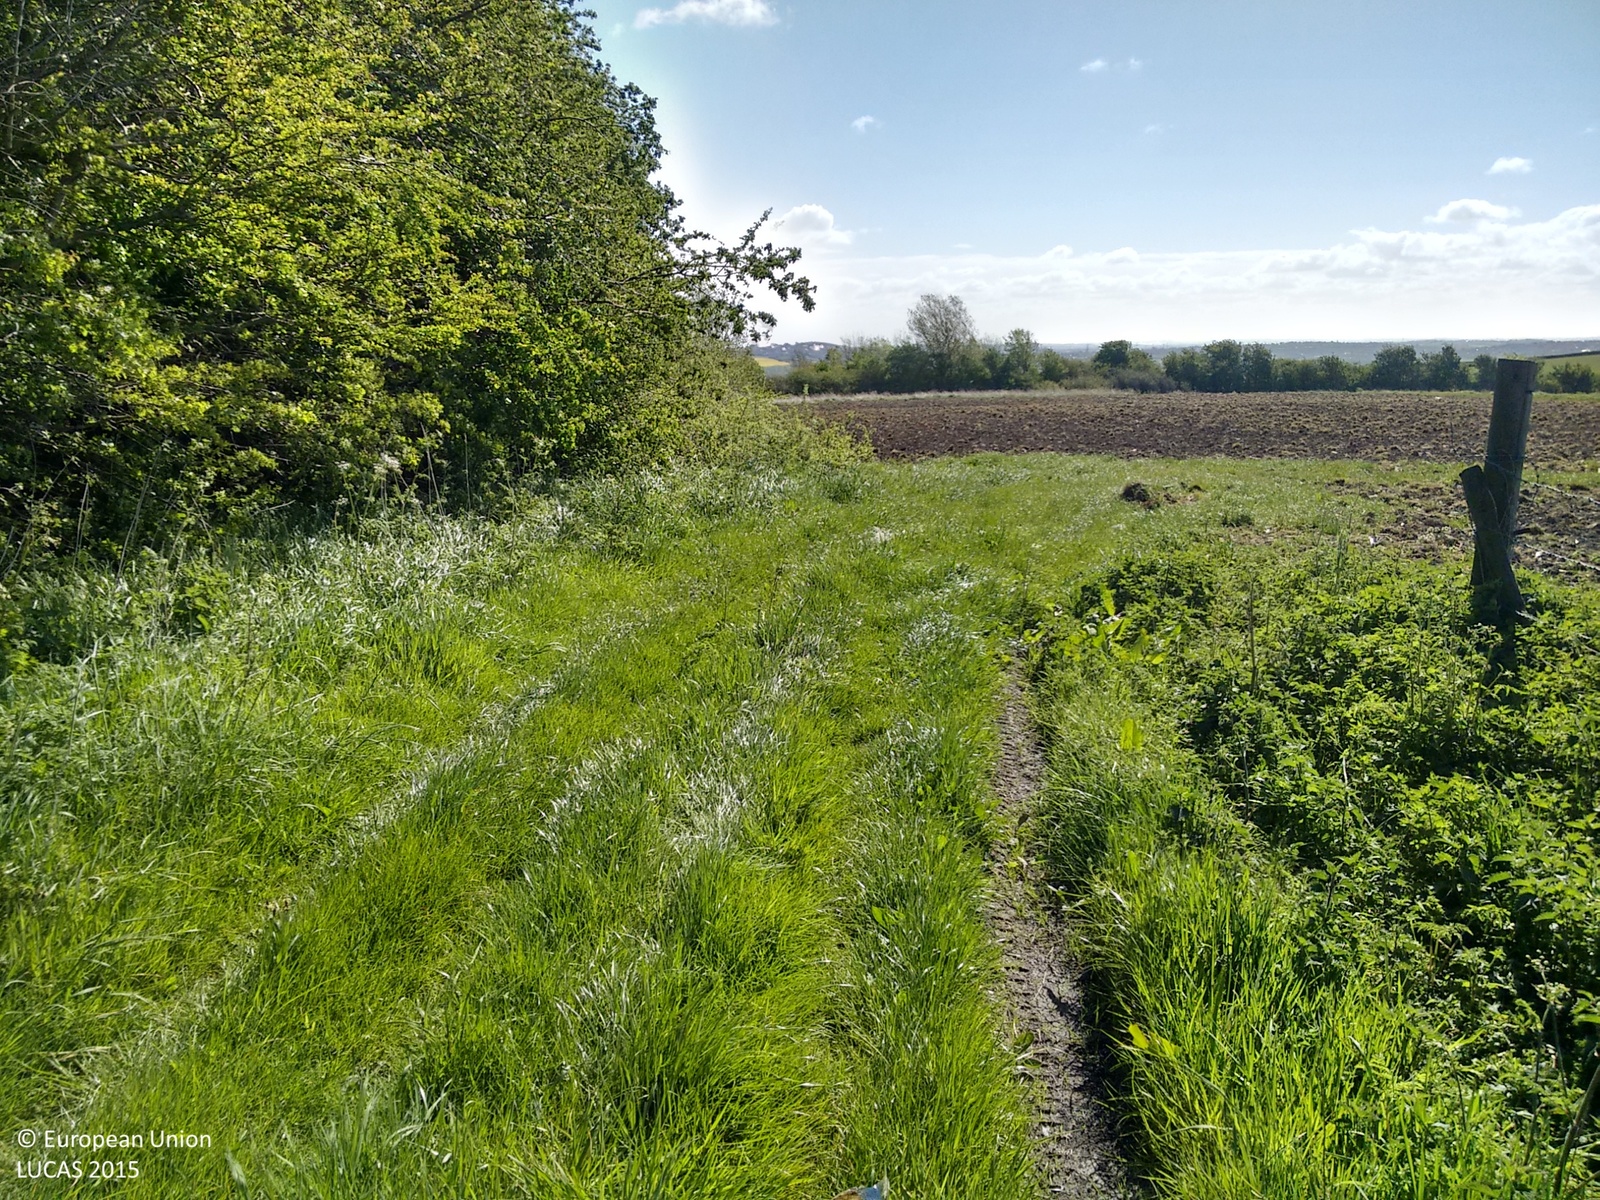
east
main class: Grassland
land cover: Grassland without tree/shrub cover
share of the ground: > 75 %
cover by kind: herbaceous plants 100 %
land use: Agriculture (excluding fallow land and kitchen gardens)
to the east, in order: Grassland without tree/shrub cover; Other bare soil; Spontaneously vegetated surfaces; Fences; Abandoned hedges; Grassland without tree/shrub cover
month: May
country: GB
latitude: 53.5894
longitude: -1.5779
